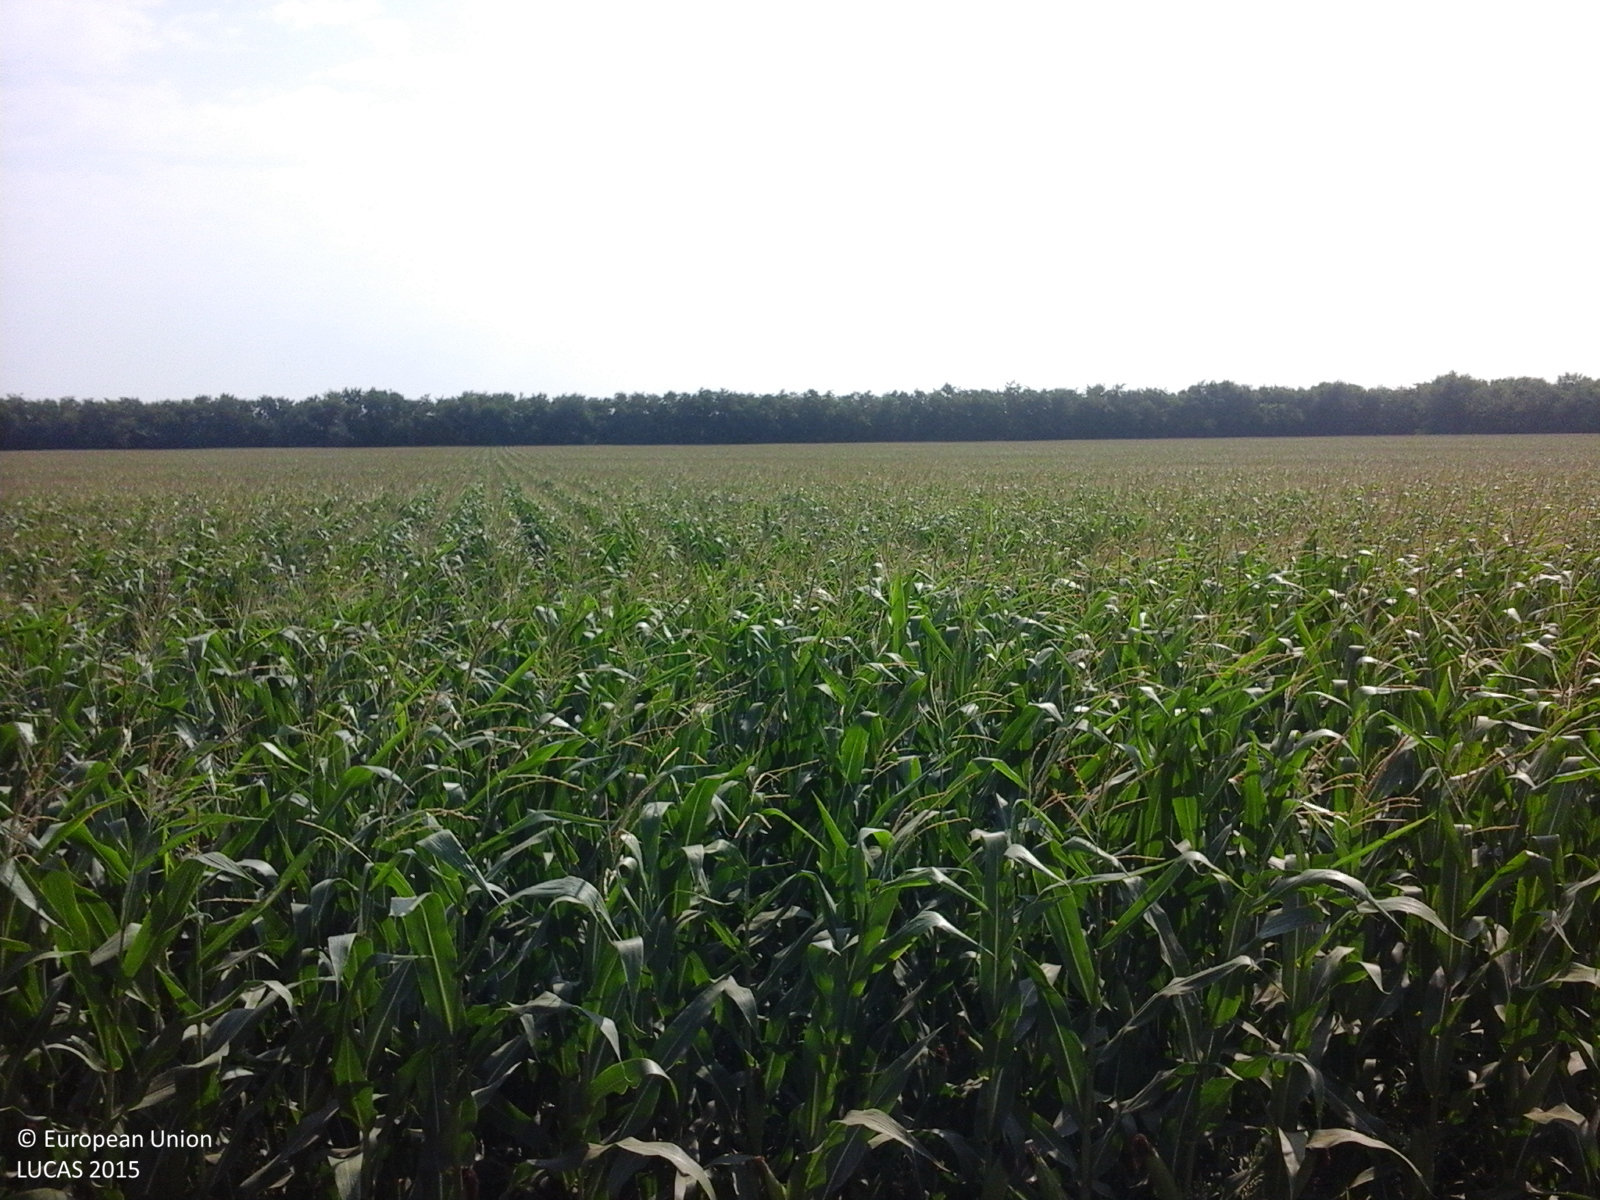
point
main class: Cropland
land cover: Maize
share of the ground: > 75 %
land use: Agriculture (excluding fallow land and kitchen gardens)
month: July
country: RO
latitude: 44.4091
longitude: 27.5350
